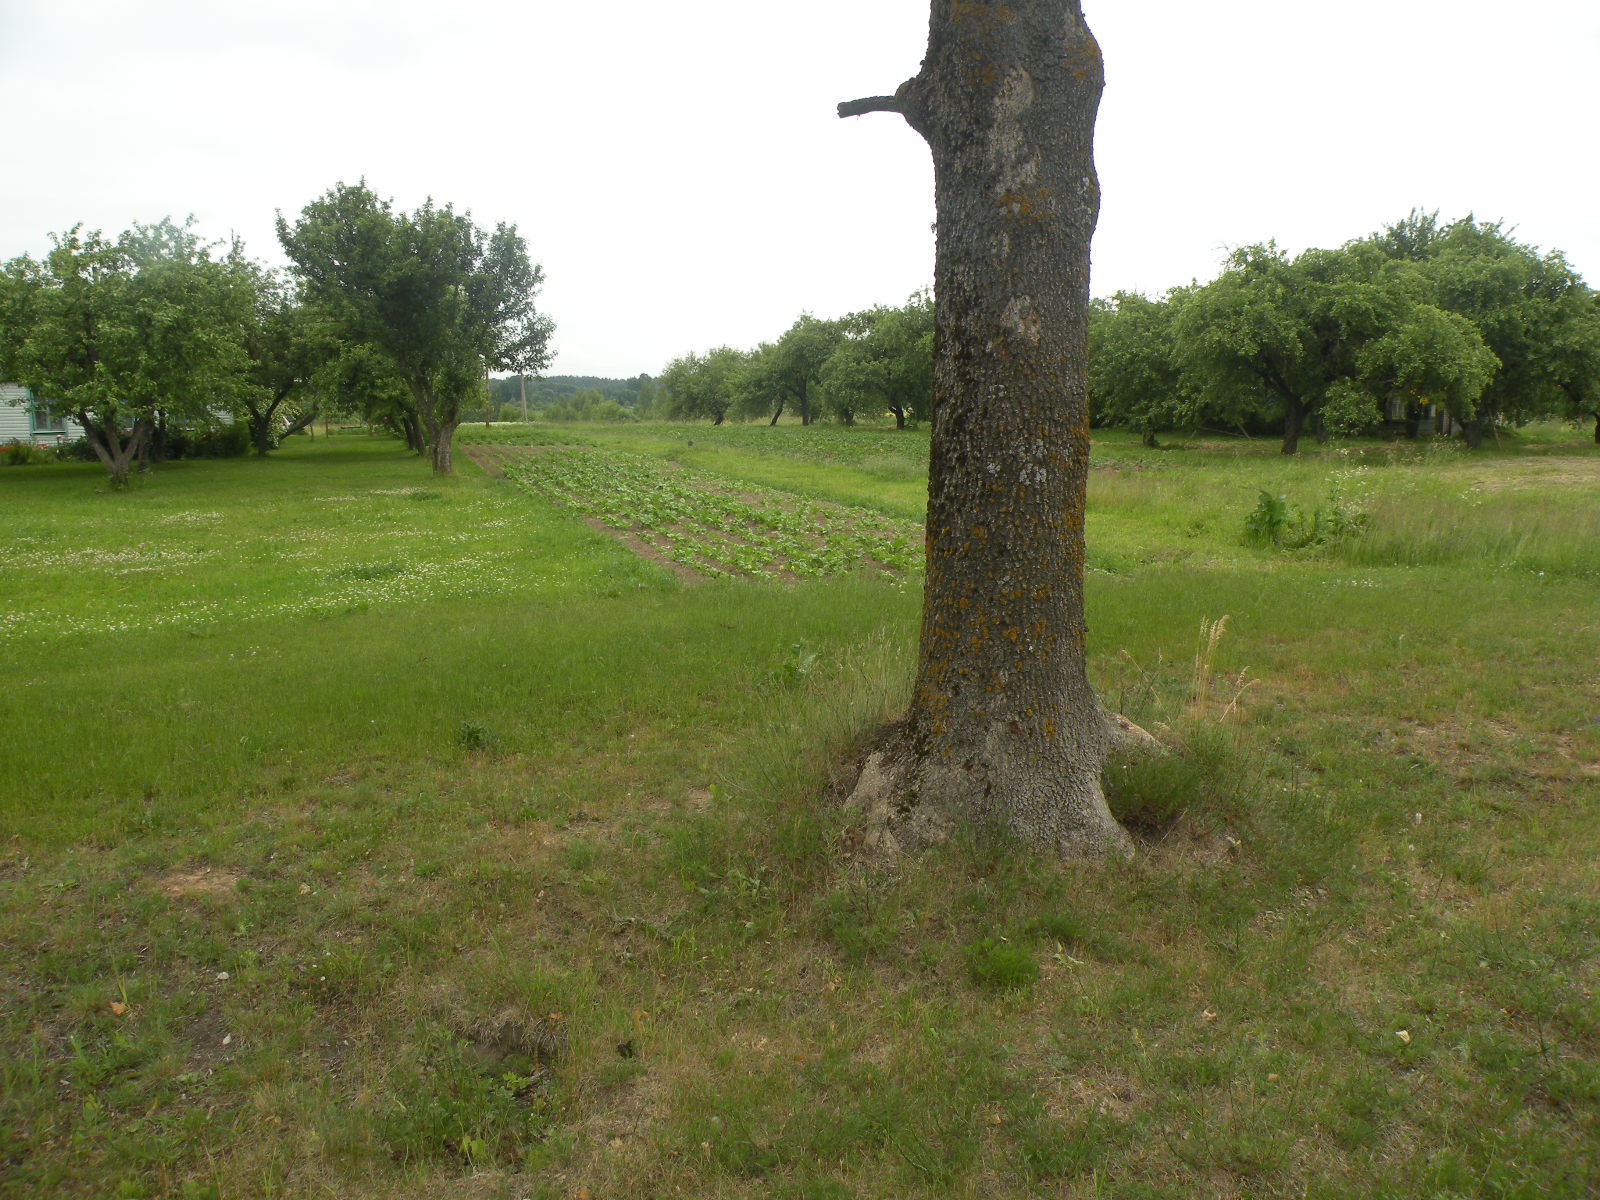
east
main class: Cropland
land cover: Other root crops
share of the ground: 50 - 75 %
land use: Kitchen garden
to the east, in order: Other root crops; Grassland without tree/shrub cover; Apple fruit; Artificial constructions in urban areas; Grassland without tree/shrub cover; Arable land (only in case pi)
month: June
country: LV
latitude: 56.0773
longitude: 26.6882
